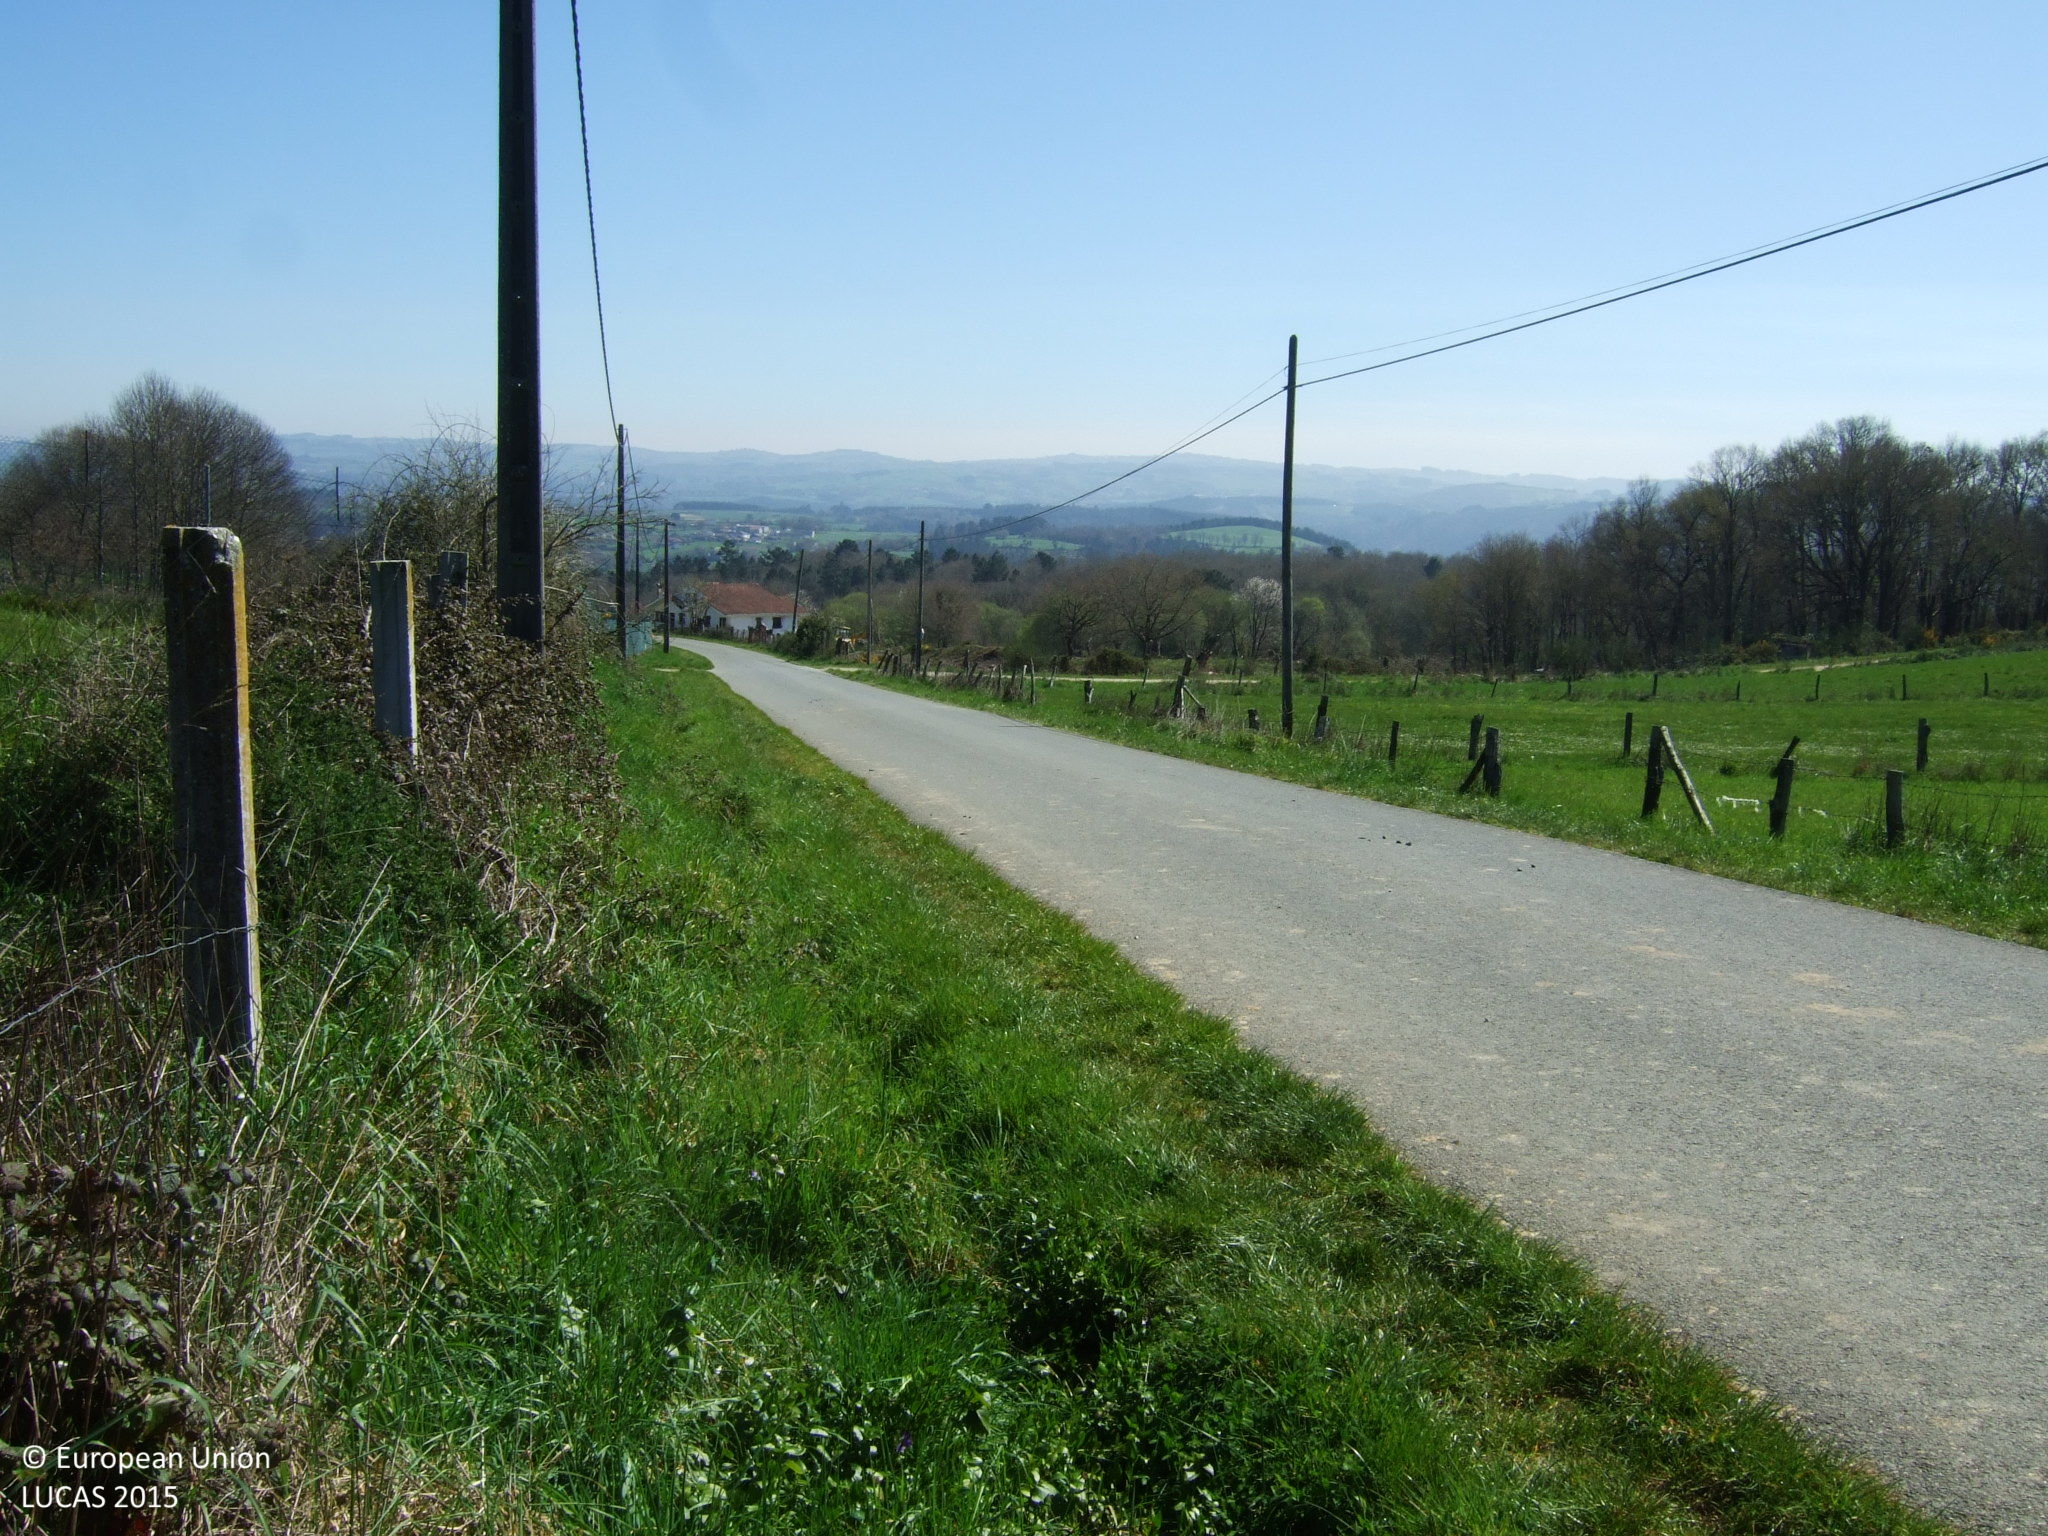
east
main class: Grassland
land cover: Grassland without tree/shrub cover
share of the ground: > 75 %
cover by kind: herbaceous plants 100 %
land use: Agriculture (excluding fallow land and kitchen gardens)
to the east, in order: Grassland without tree/shrub cover; Fences; Grassland without tree/shrub cover; Fences; Tracks; Grassland without tree/shrub cover; Fences; Grassland without tree/shrub cover; Fences; Electric lines; Grass margins; Artificial constructions in urban areas
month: April
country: ES
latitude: 42.6960
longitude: -7.7415
